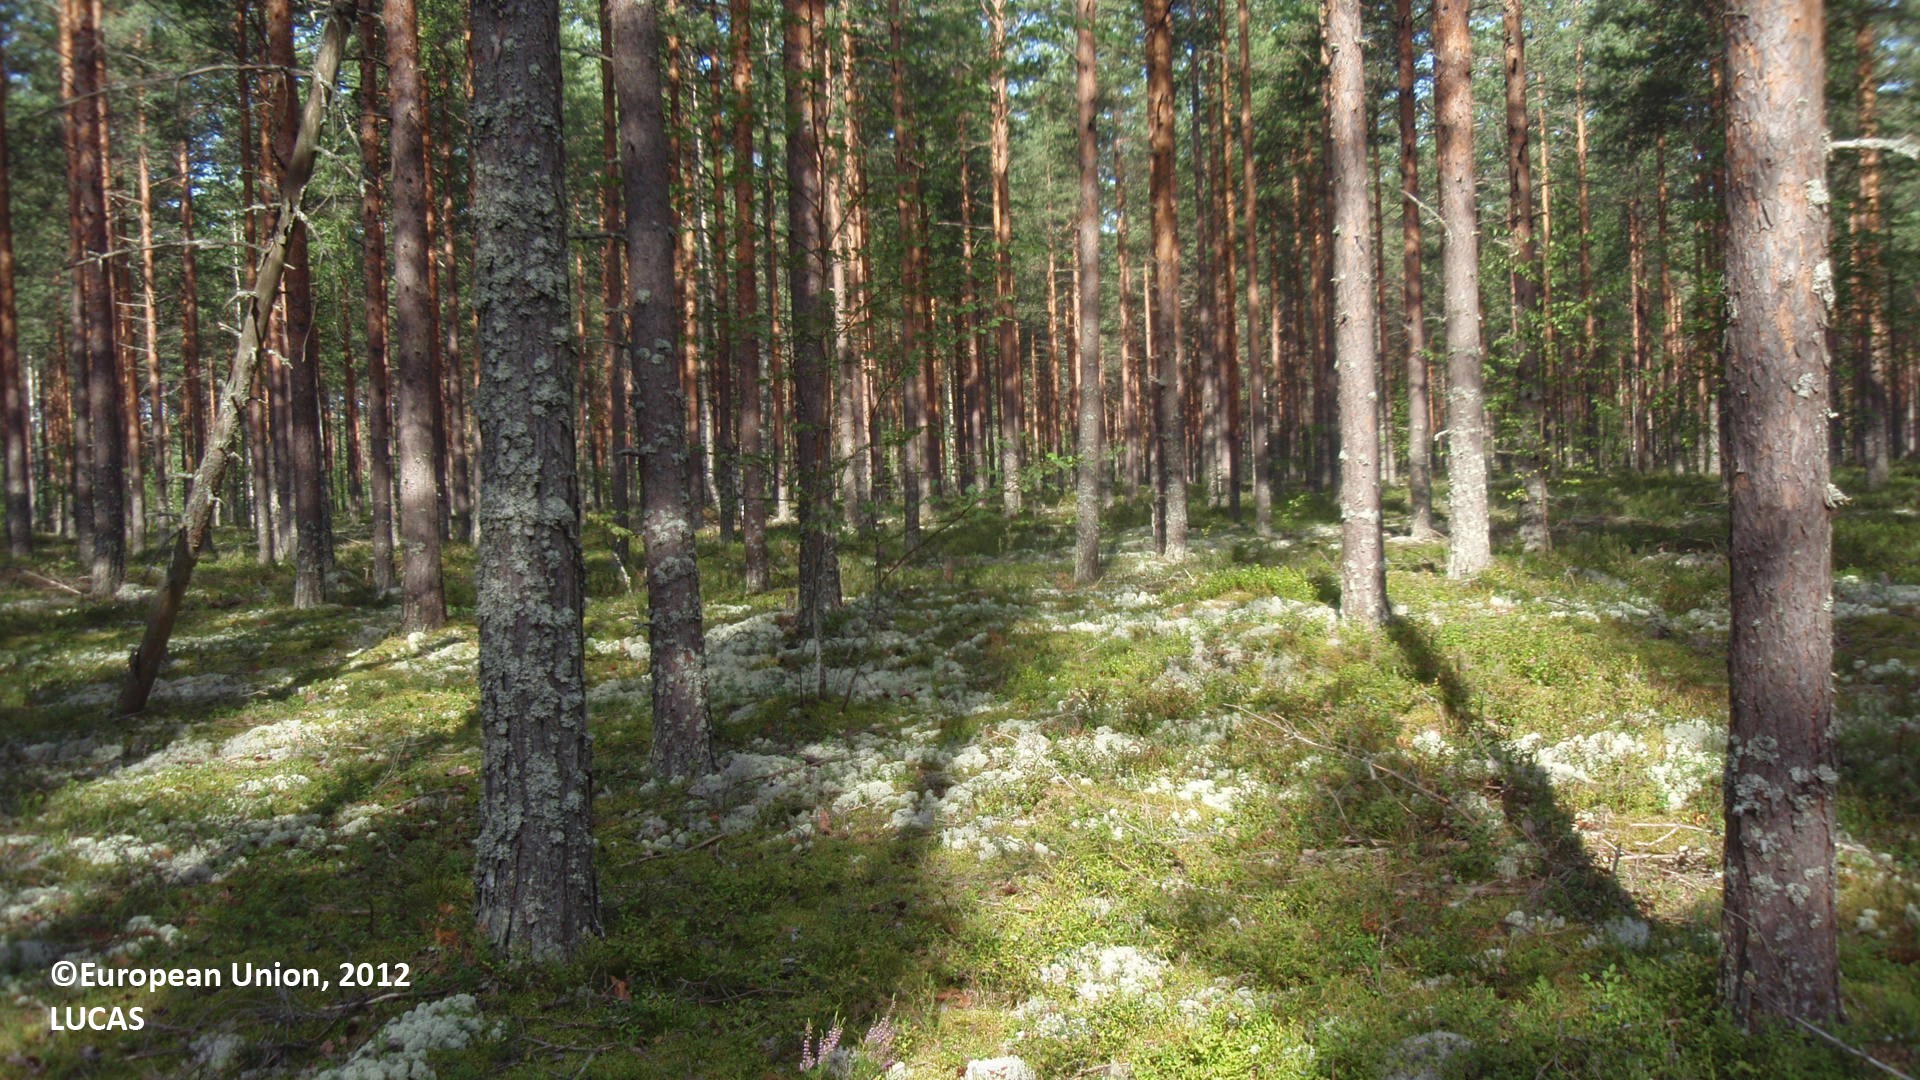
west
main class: Woodland
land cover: Pine dominated coniferous woodland
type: boreal forest
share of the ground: 50 - 75 %
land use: Forestry
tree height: > 5 m
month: August
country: FI
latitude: 61.2654
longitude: 28.0427
